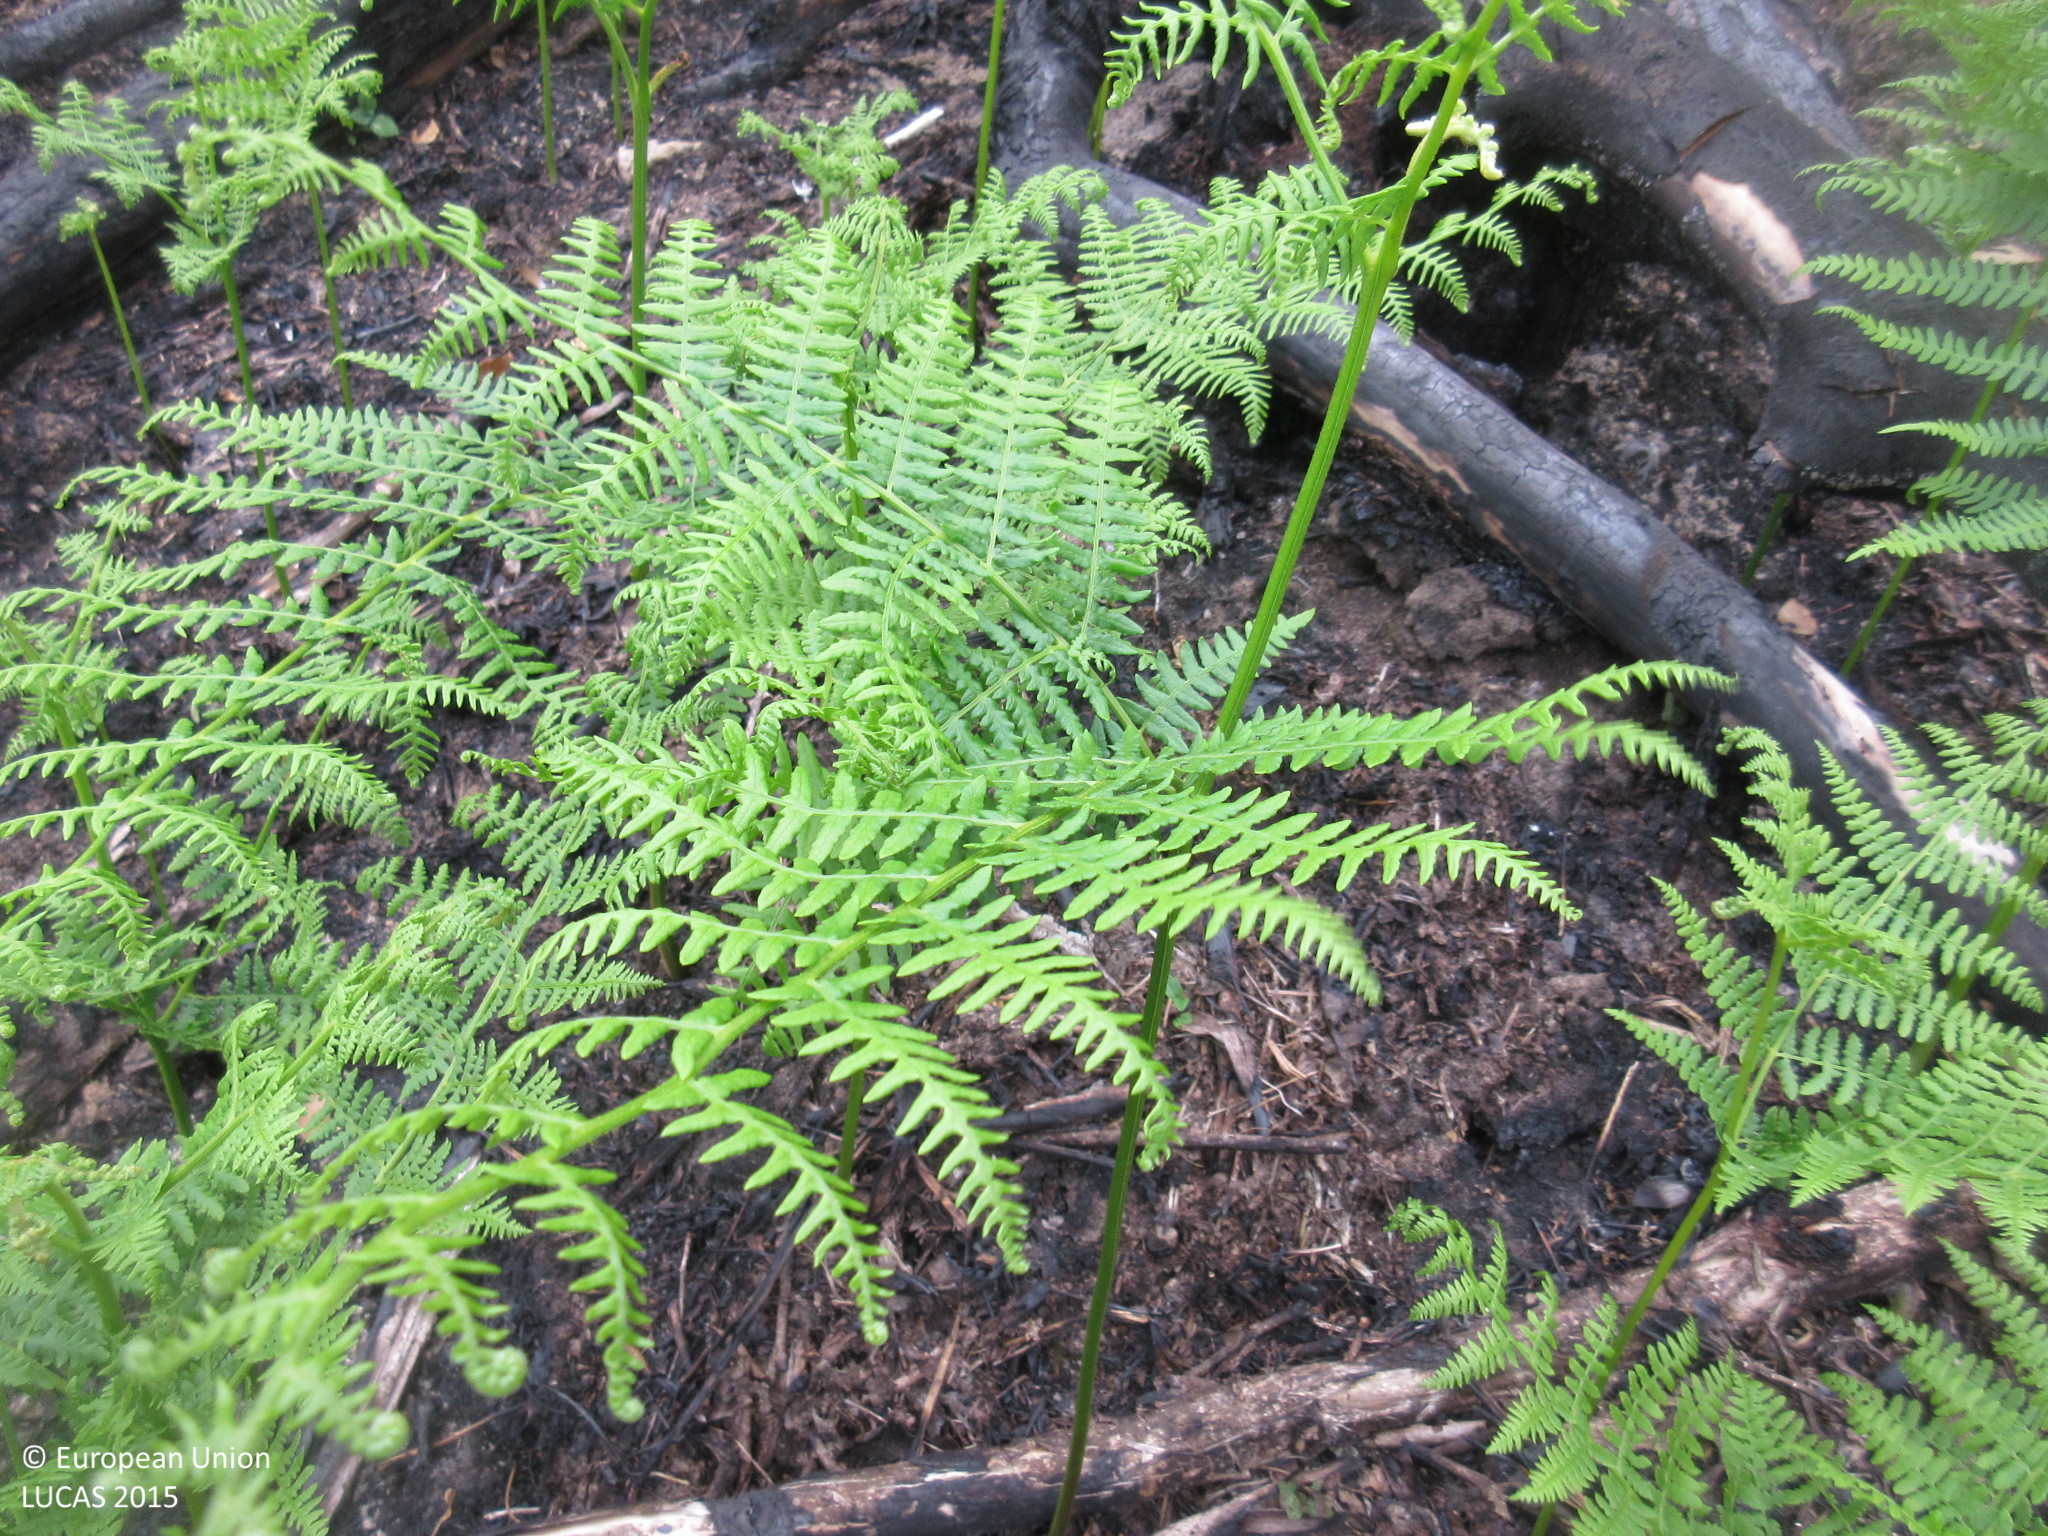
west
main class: Grassland
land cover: Grassland without tree/shrub cover
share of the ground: 25 - 50 %
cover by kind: unconsolidated bare surface 70 %, herbaceous plants 30 %
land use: Semi-natural and natural areas not in use
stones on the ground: < 10 %
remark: Burnt area
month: June
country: ES
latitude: 43.3246
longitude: -3.4469
